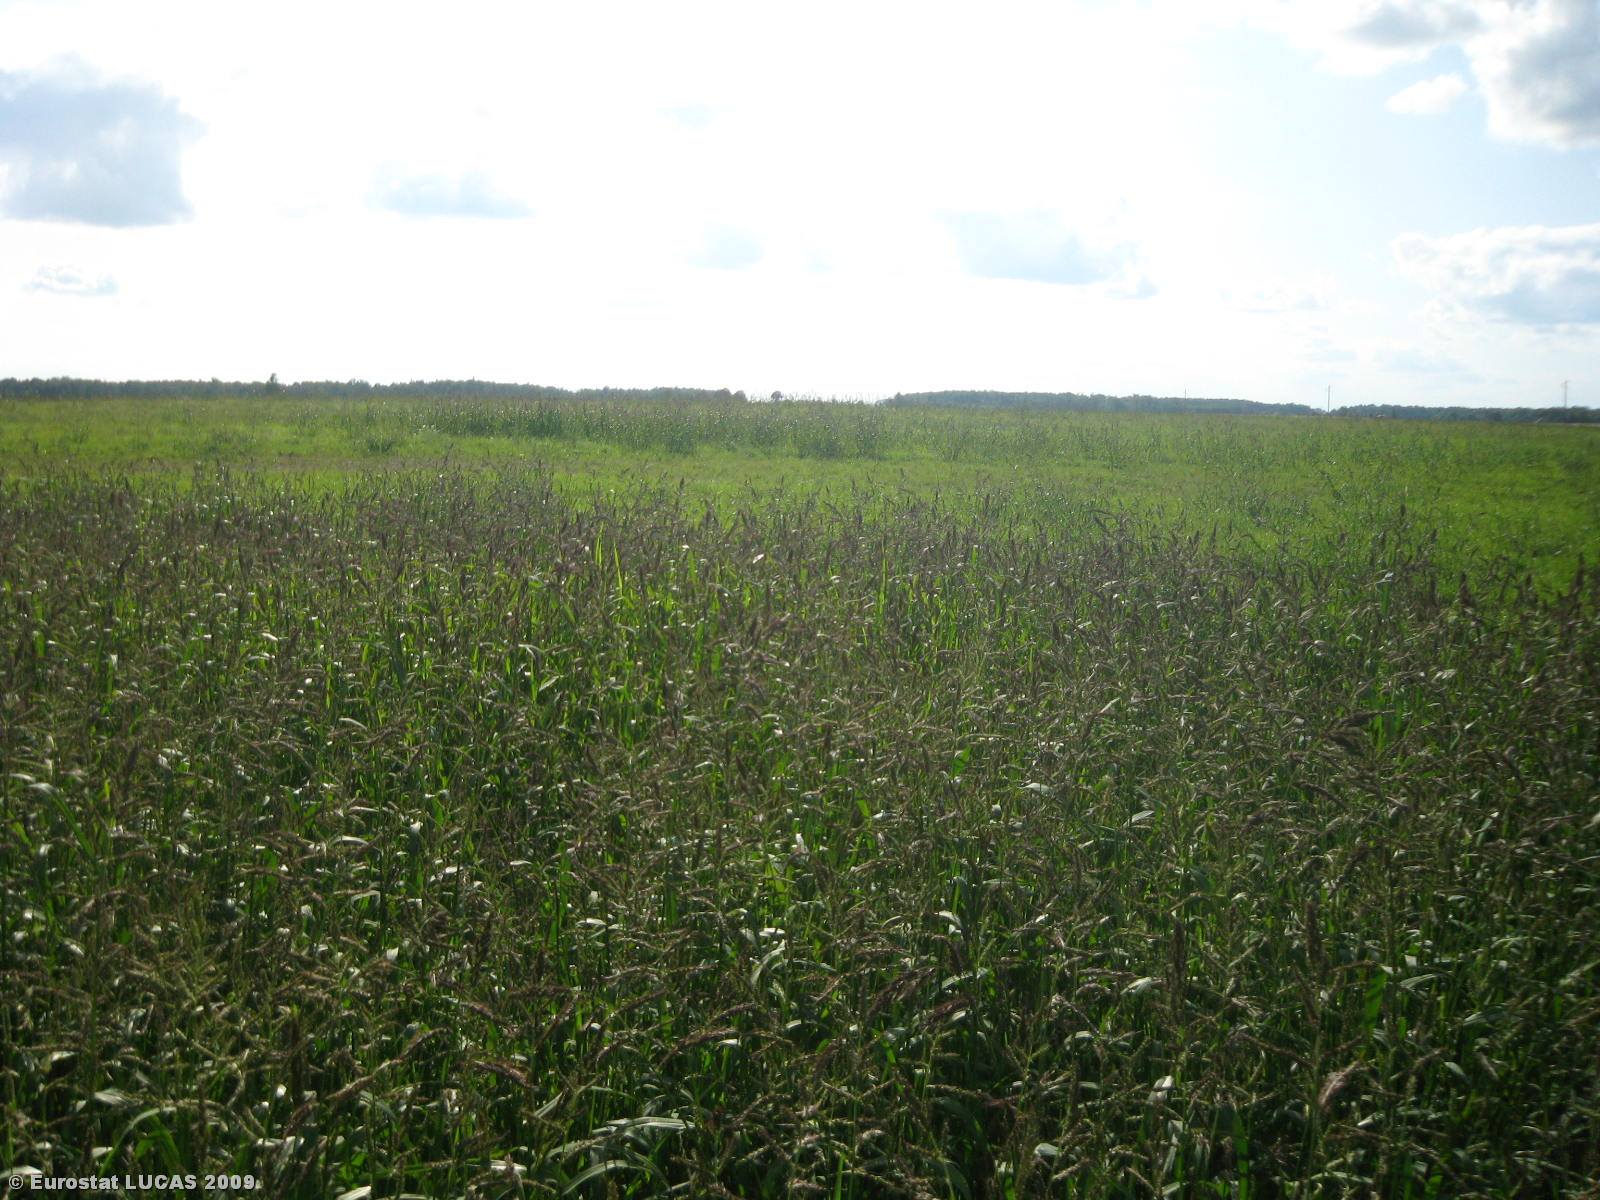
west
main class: Grassland
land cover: Grassland without tree/shrub cover
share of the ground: > 75 %
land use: Fallow land
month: August
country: LT
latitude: 55.2801
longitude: 23.7336
